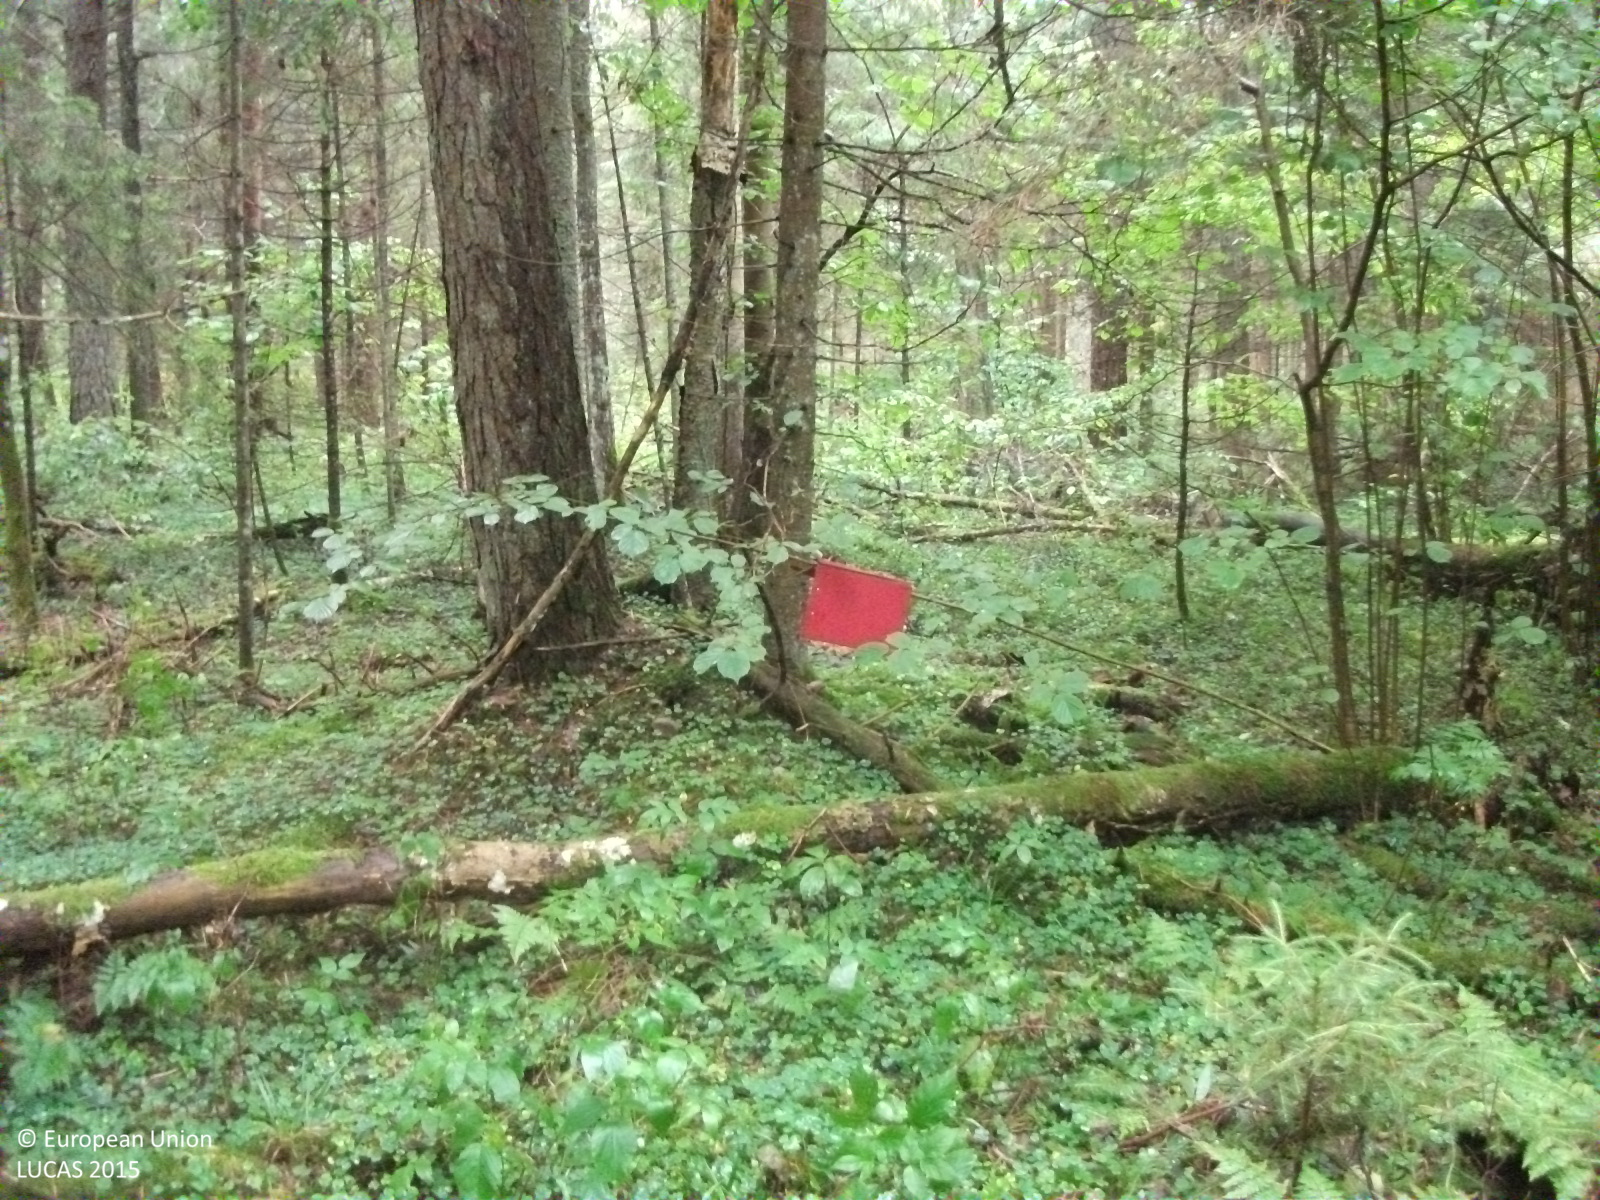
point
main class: Woodland
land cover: Spruce dominated coniferous woodland
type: hemiboreal forest and nemoral coniferous forest and mixed broadleaved-coniferous forest
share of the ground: > 75 %
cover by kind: coniferous forest trees 80 %, broadleaved forest trees 10 %, shrubs 5 %, herbaceous plants 5 %
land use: Forestry
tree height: > 5 m
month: September
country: LV
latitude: 57.5984
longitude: 24.7709
